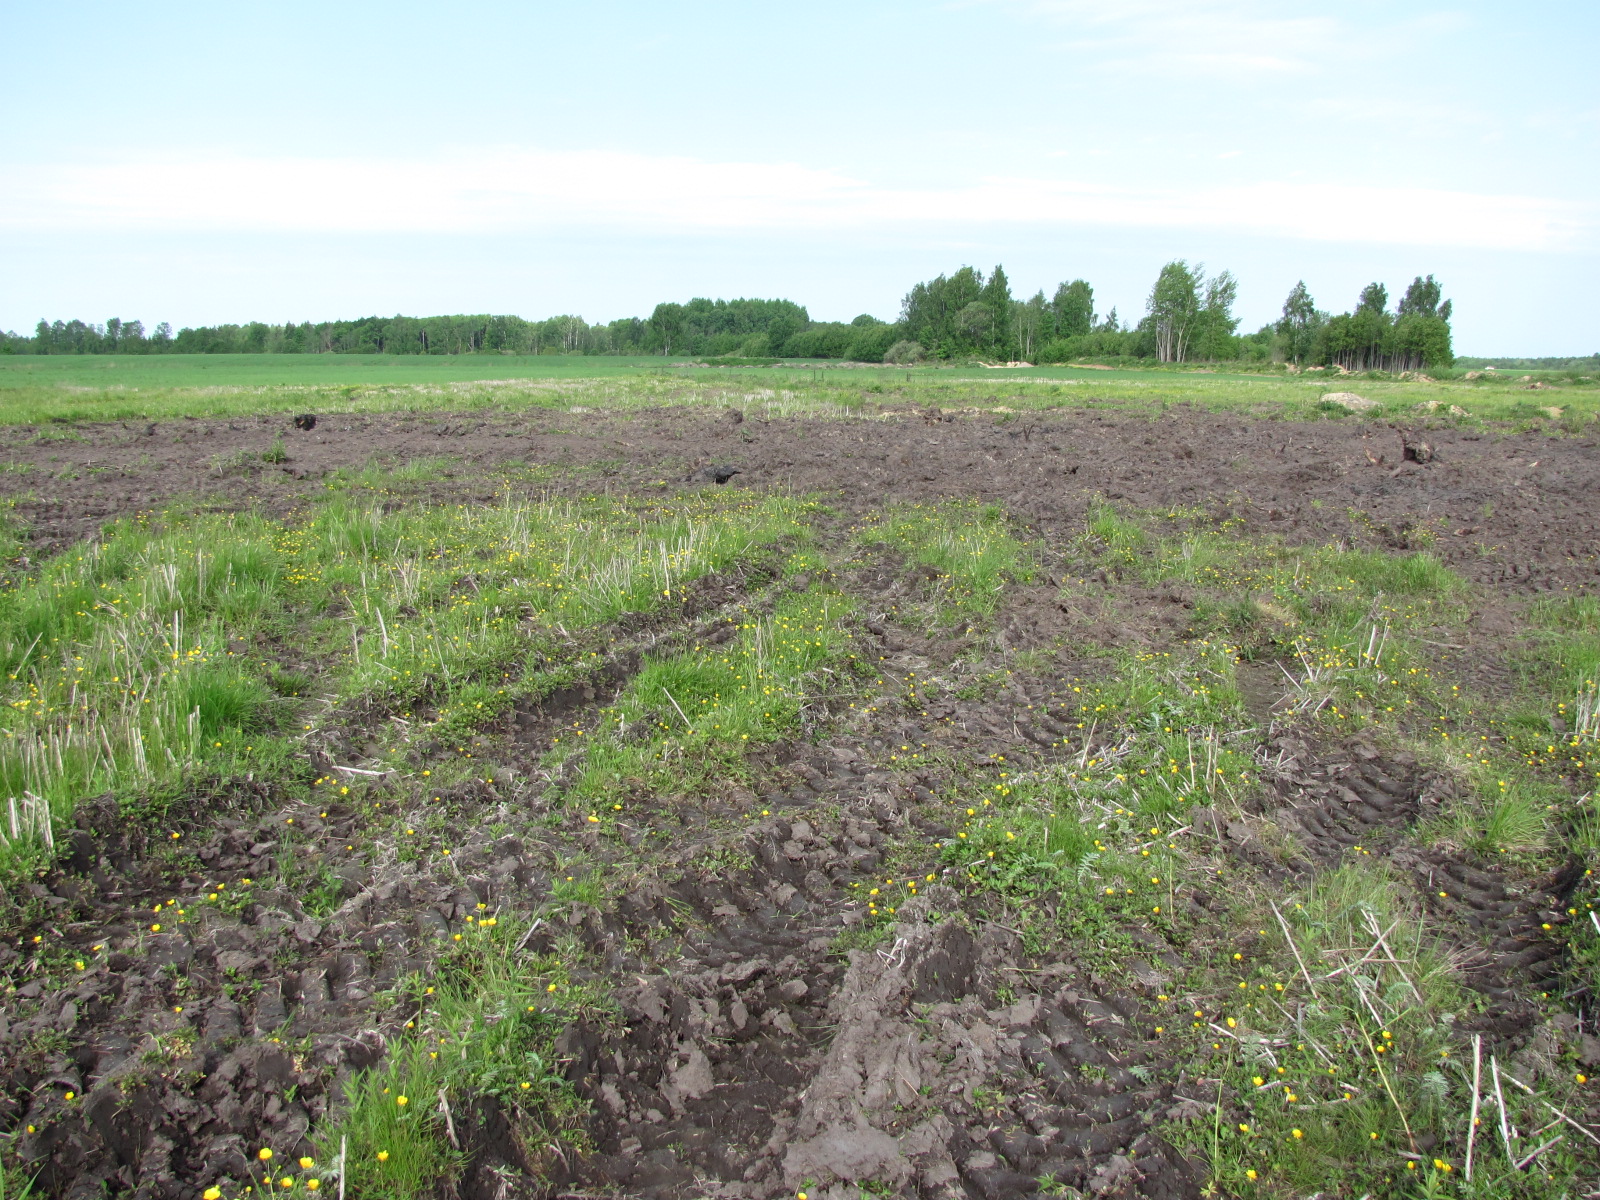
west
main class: Grassland
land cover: Spontaneously vegetated surfaces
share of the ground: 50 - 75 %
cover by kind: herbaceous plants 70 %, unconsolidated bare surface 30 %
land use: Fallow land
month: May
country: LV
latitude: 56.5354
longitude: 24.1203
